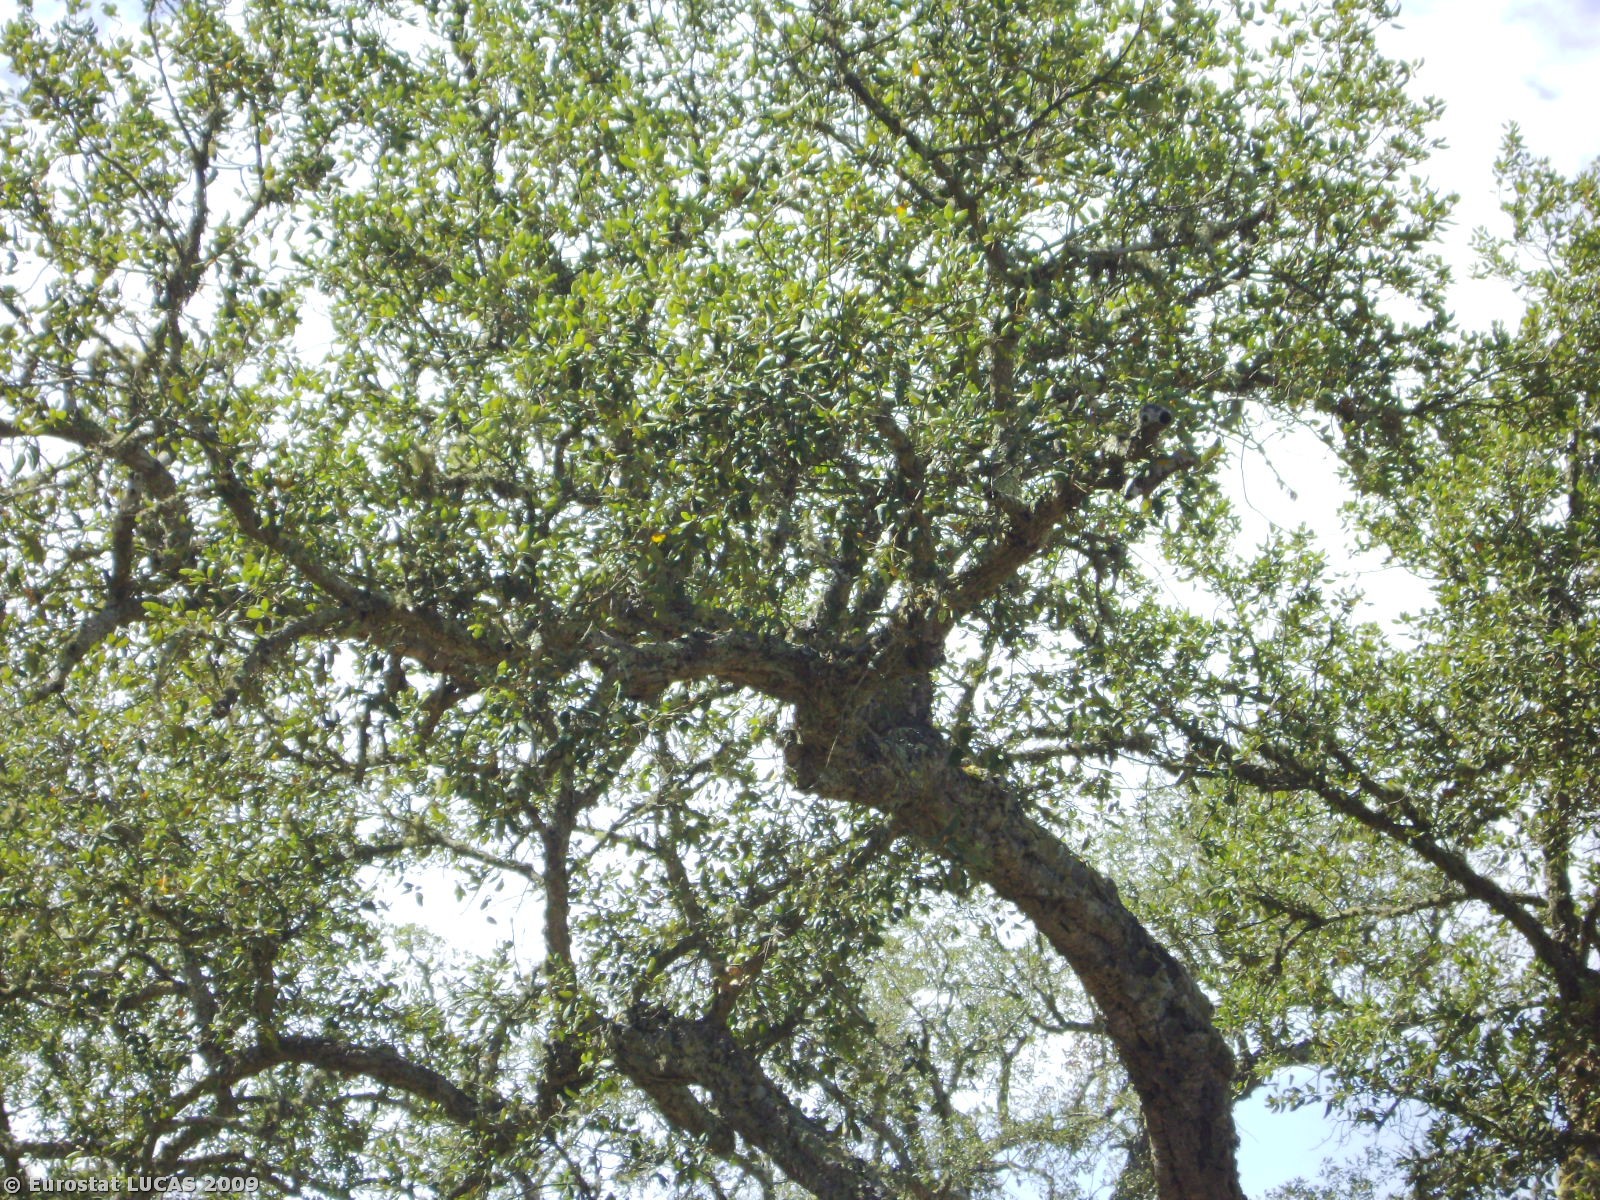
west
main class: Woodland
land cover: Broadleaved woodland
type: broadleaved evergreen forest
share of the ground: 50 - 75 %
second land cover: Shrubland with sparse tree cover
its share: 50 - 75 %
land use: Forestry
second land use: Unused
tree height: > 5 m
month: August
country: PT
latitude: 38.0668
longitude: -7.1211
